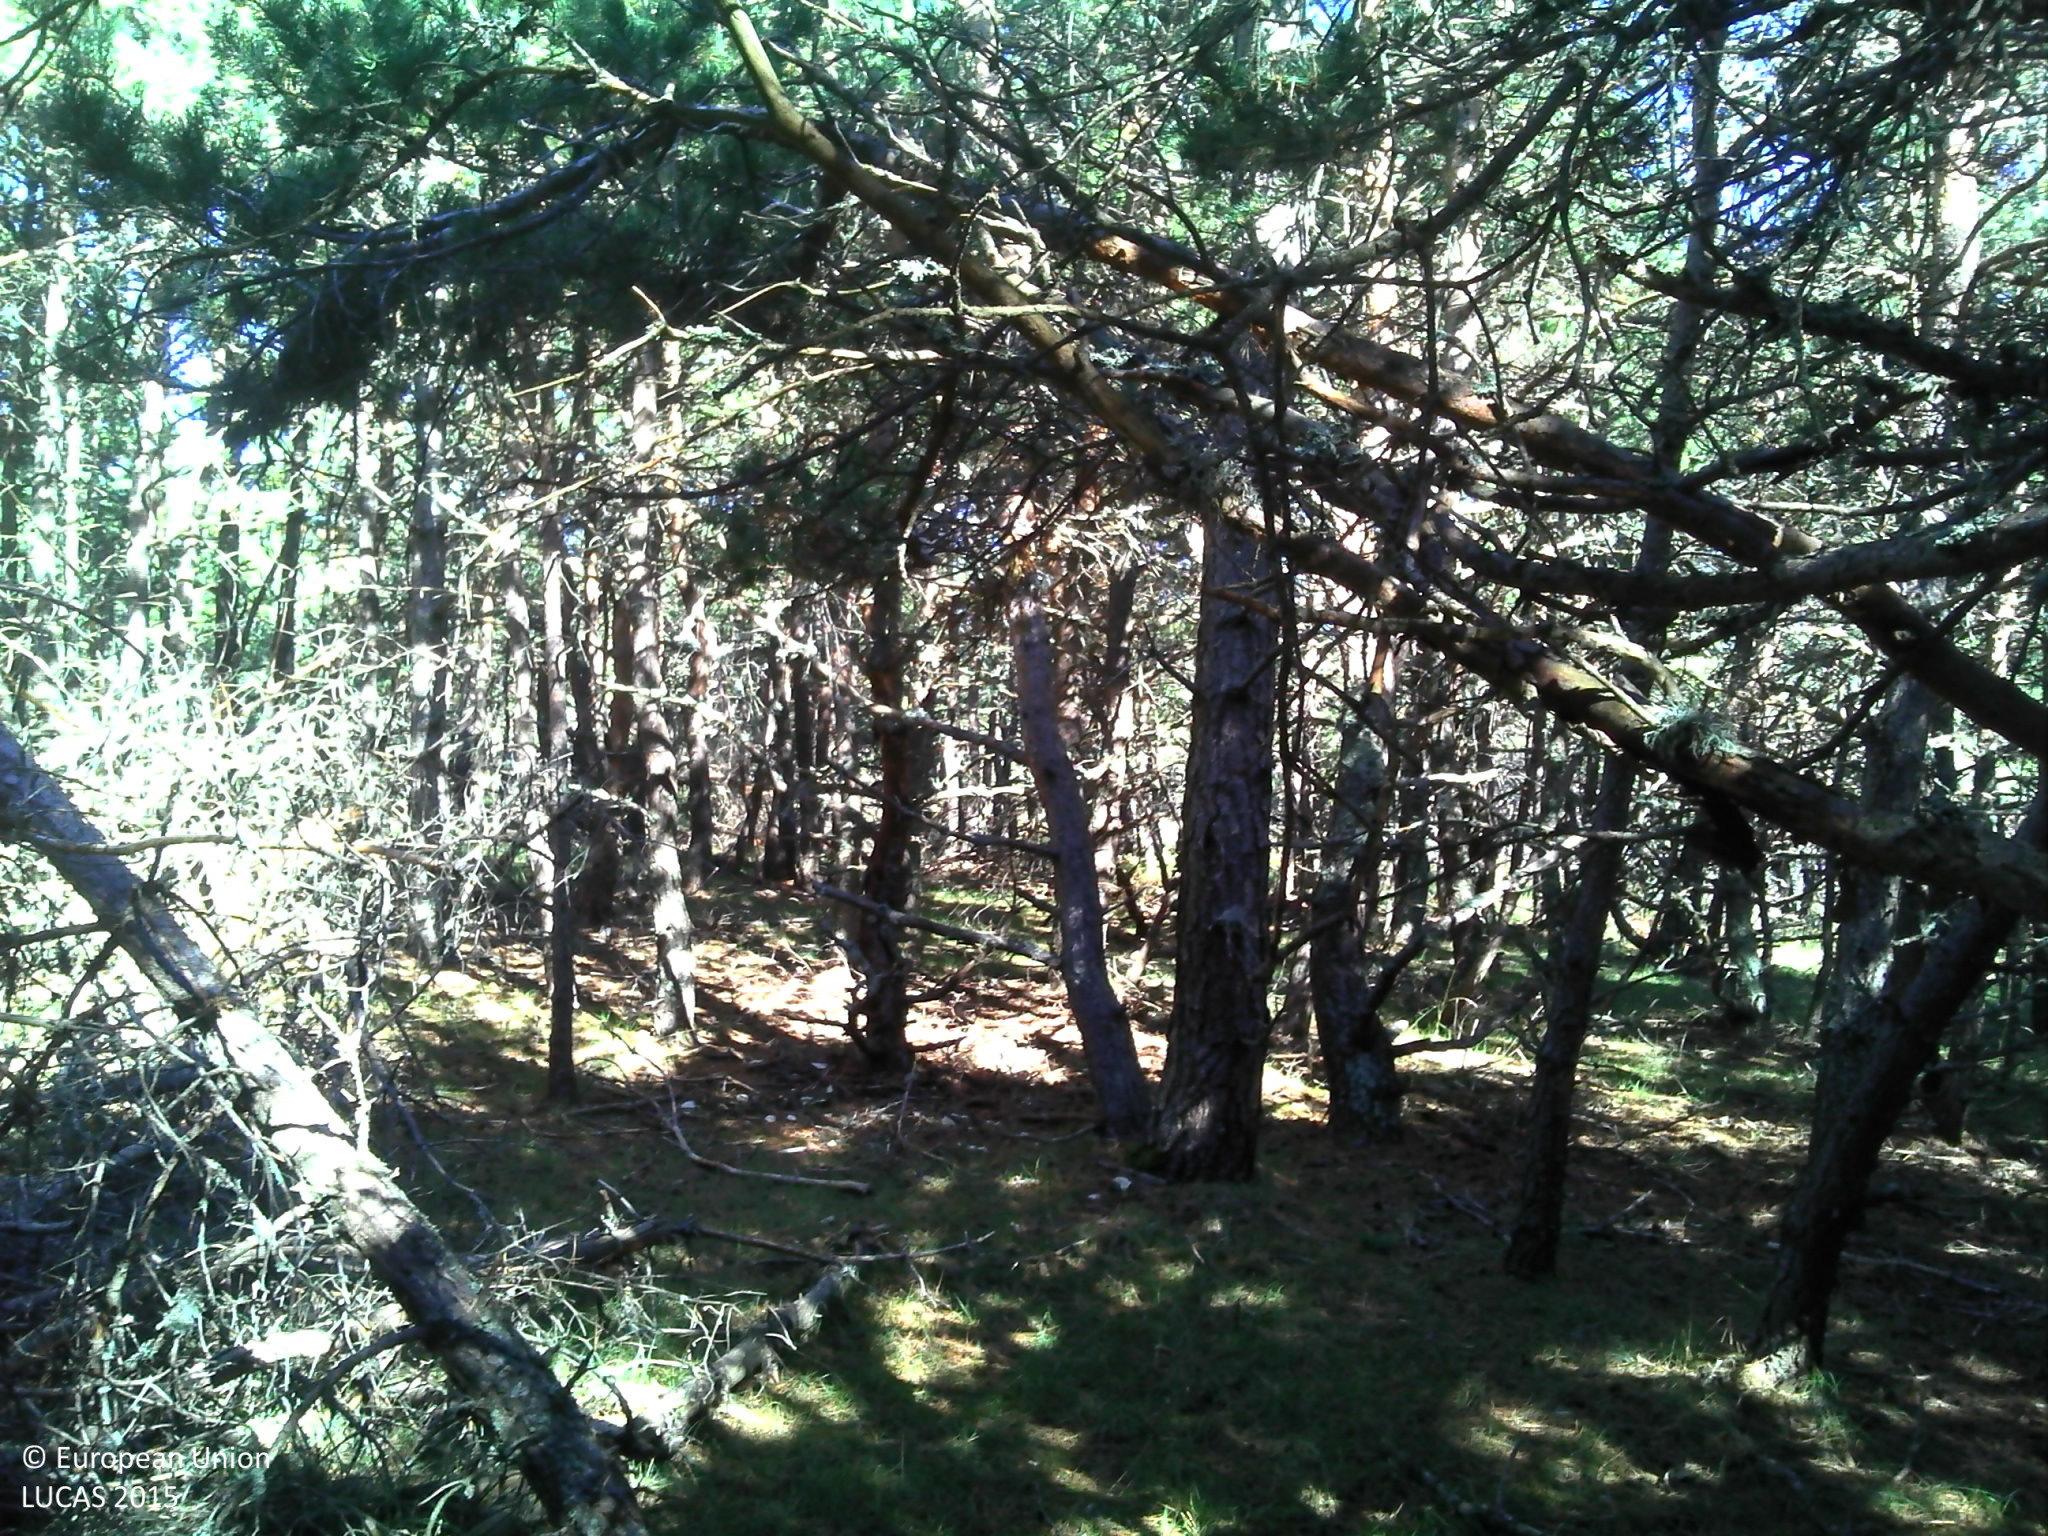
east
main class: Woodland
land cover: Pine dominated coniferous woodland
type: alpine coniferous forest
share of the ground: > 75 %
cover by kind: coniferous forest trees 80 %, herbaceous plants 15 %, broadleaved forest trees 5 %
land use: Forestry
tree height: > 5 m
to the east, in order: Pine dominated coniferous woodland; Tracks; Pine dominated coniferous woodland; Shrubland with sparse tree cover; Pine dominated coniferous woodland; Shrubland with sparse tree cover
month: June
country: FR
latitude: 44.1645
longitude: 5.5434
